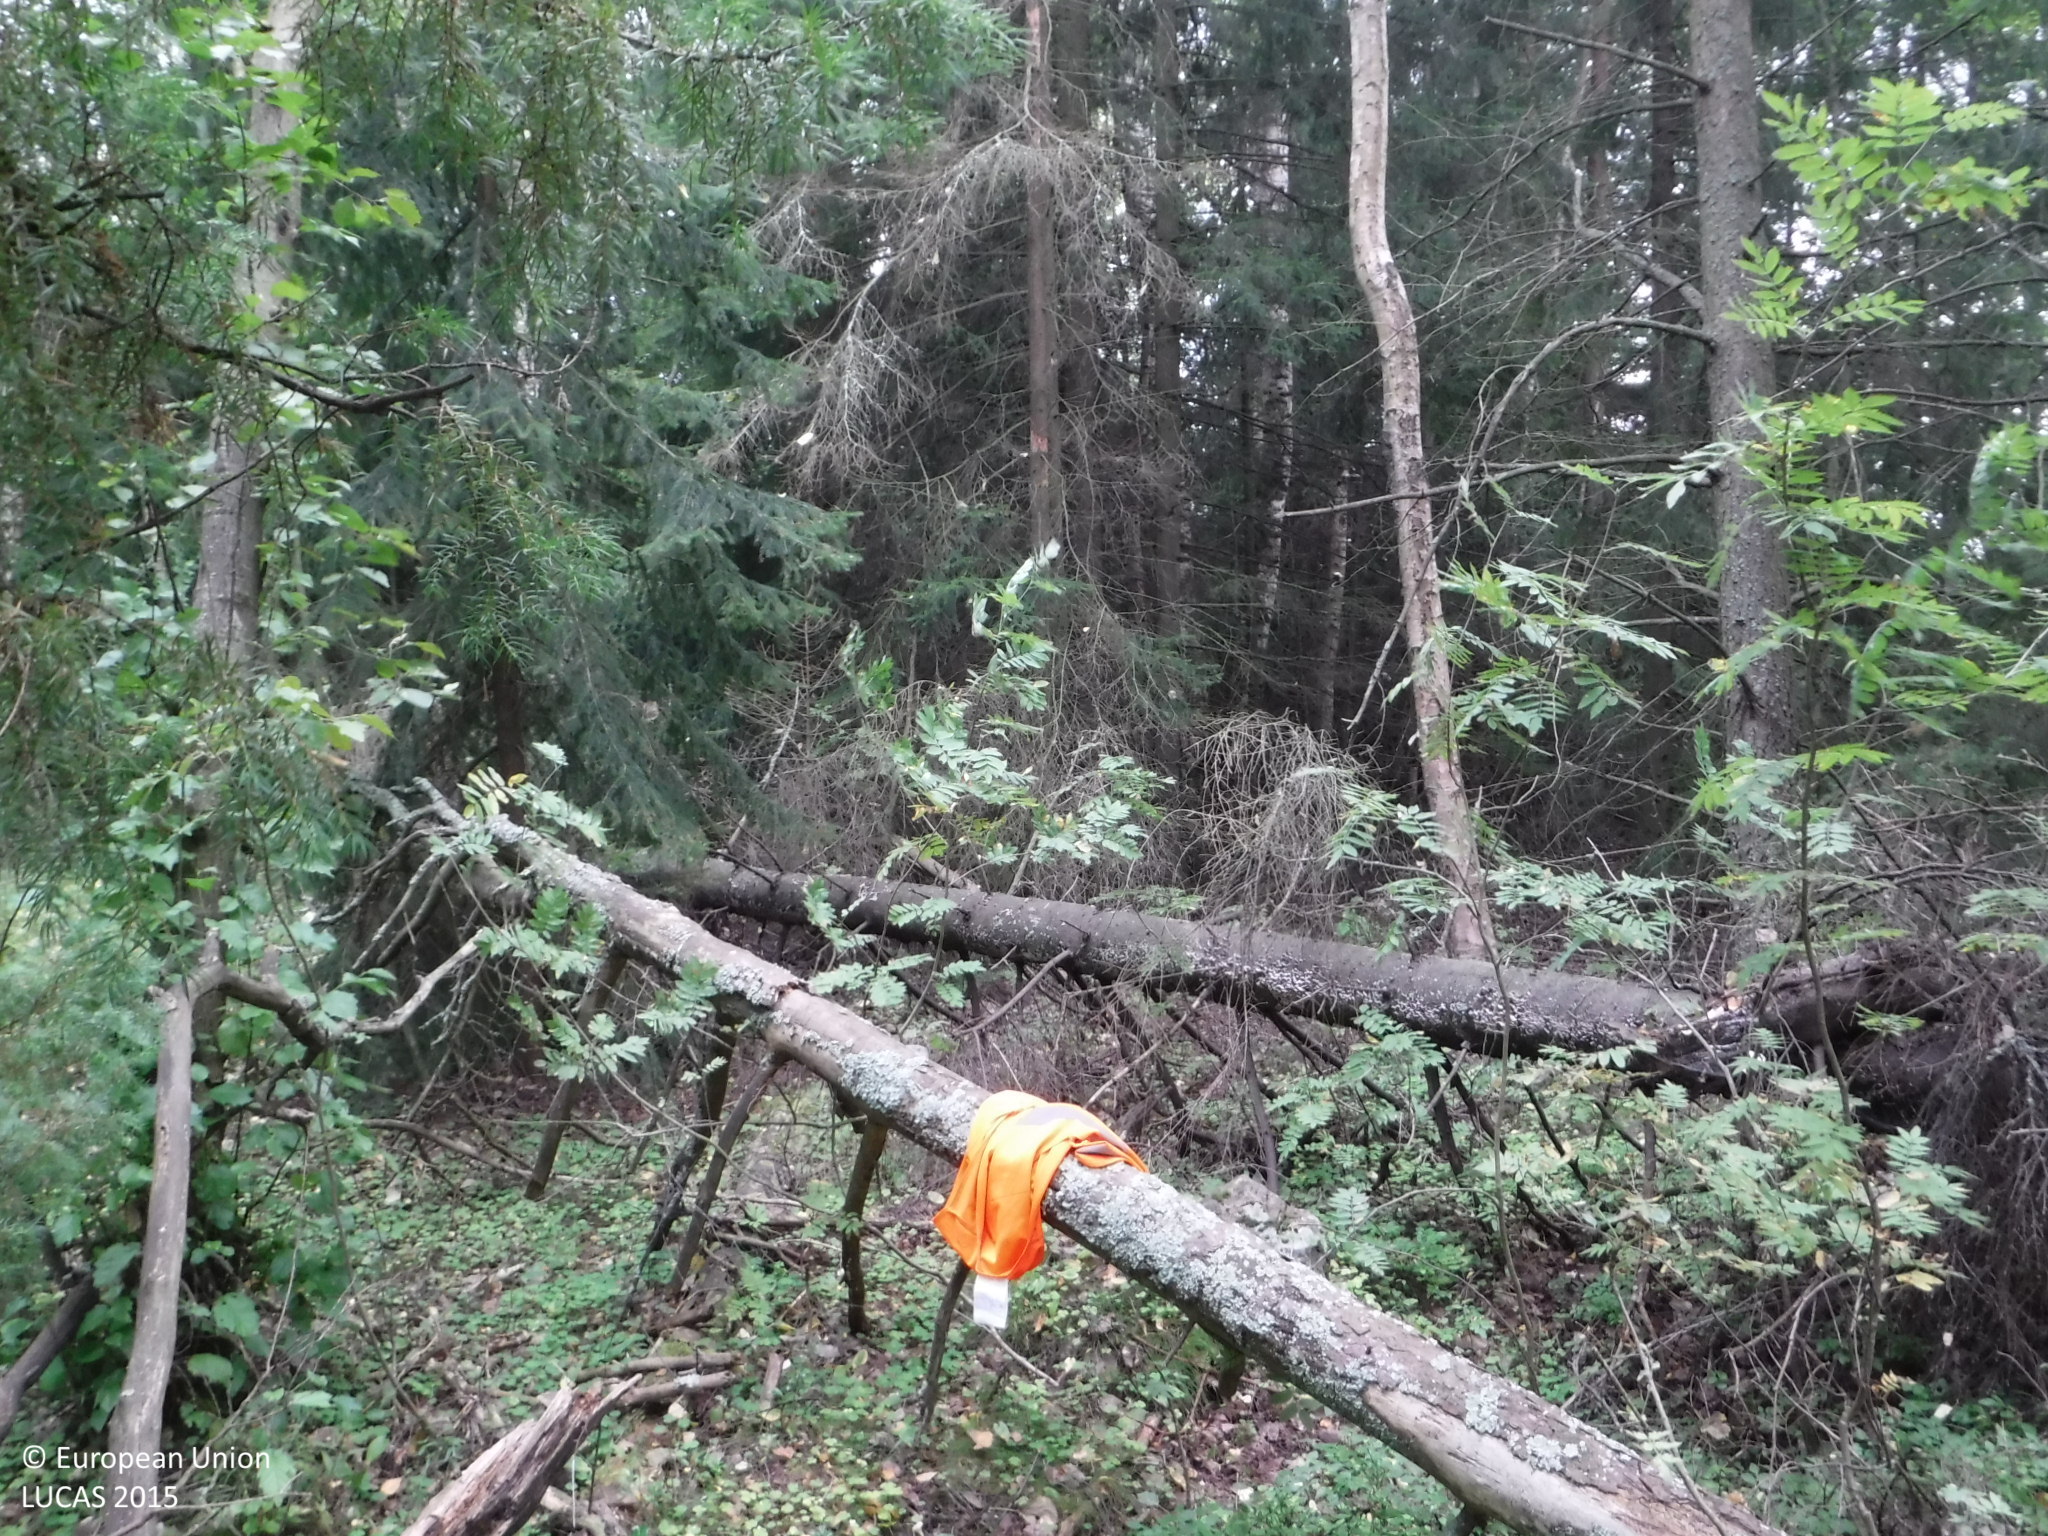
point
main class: Woodland
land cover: Other mixed woodland
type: boreal forest
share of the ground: > 75 %
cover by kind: broadleaved forest trees 40 %, coniferous forest trees 35 %, herbaceous plants 10 %, unconsolidated bare surface 10 %, shrubs 5 %
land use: Semi-natural and natural areas not in use
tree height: > 5 m
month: September
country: FI
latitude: 61.3418
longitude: 22.0397
